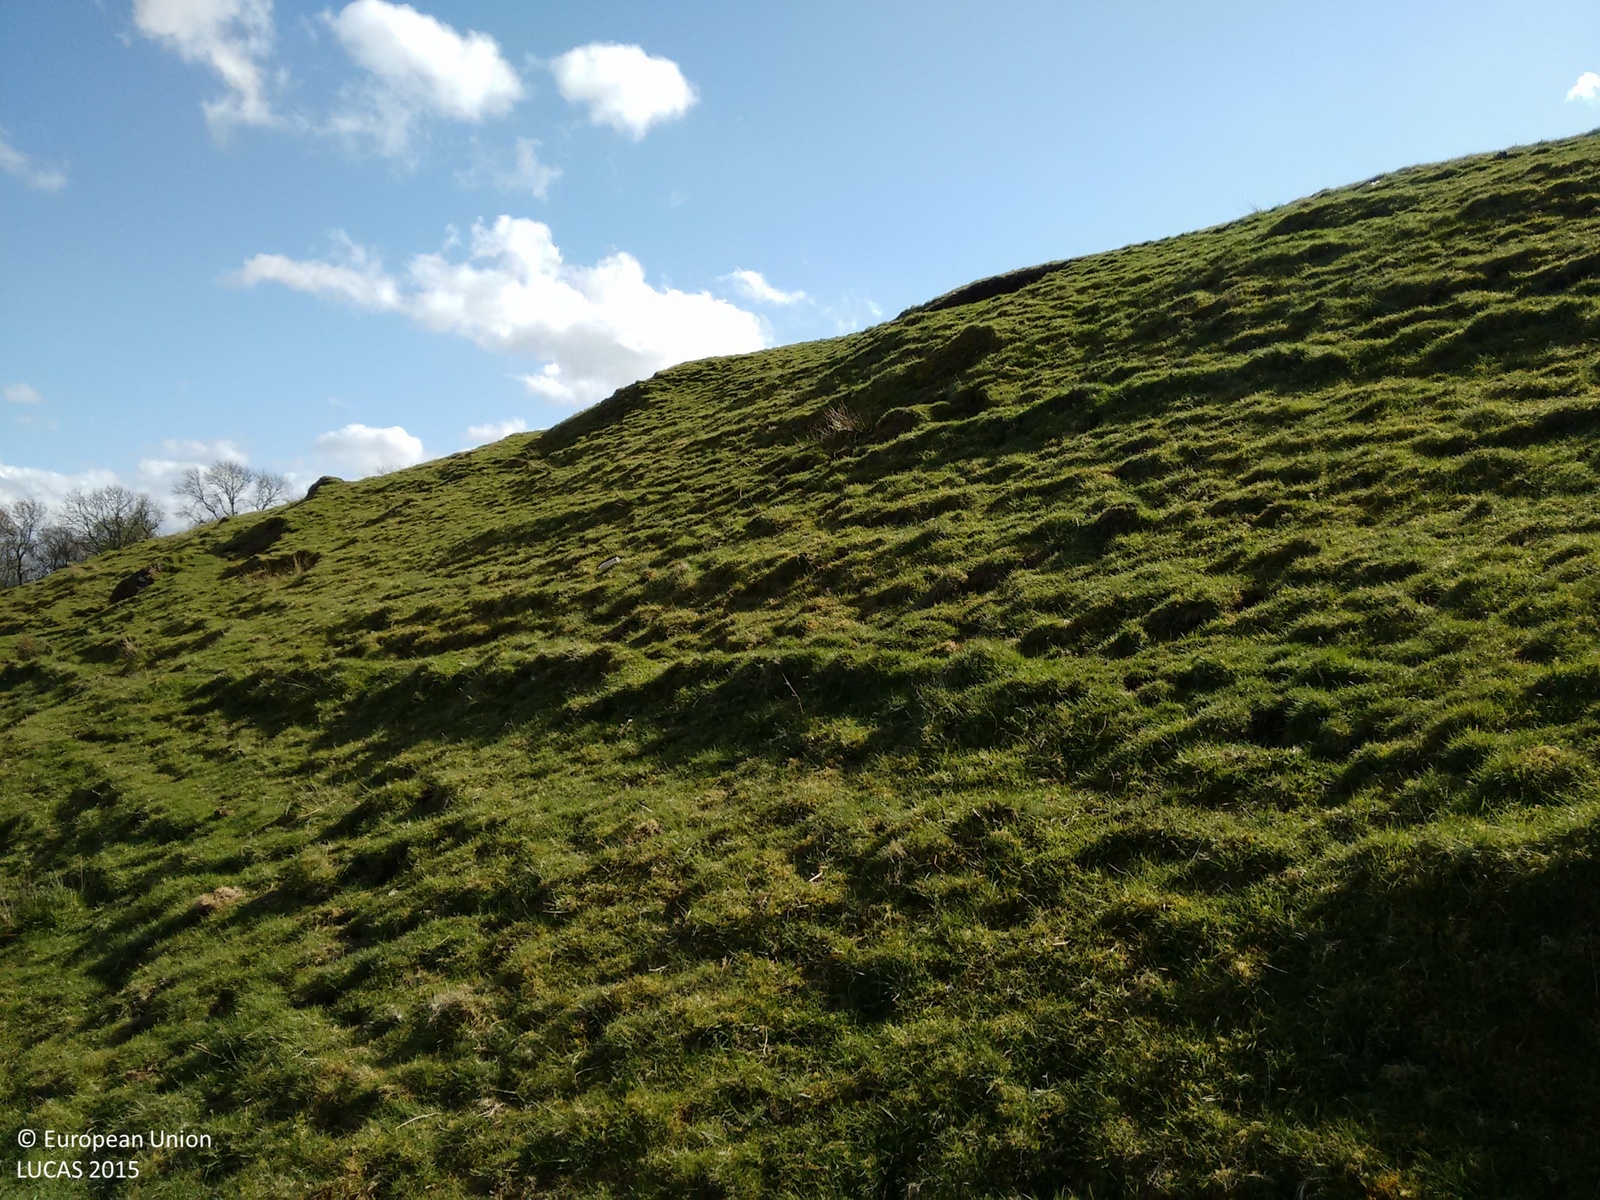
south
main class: Grassland
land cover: Grassland without tree/shrub cover
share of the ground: > 75 %
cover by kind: herbaceous plants 100 %
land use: Agriculture (excluding fallow land and kitchen gardens)
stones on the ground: < 10 %
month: May
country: GB
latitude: 56.1557
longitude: -3.9144
